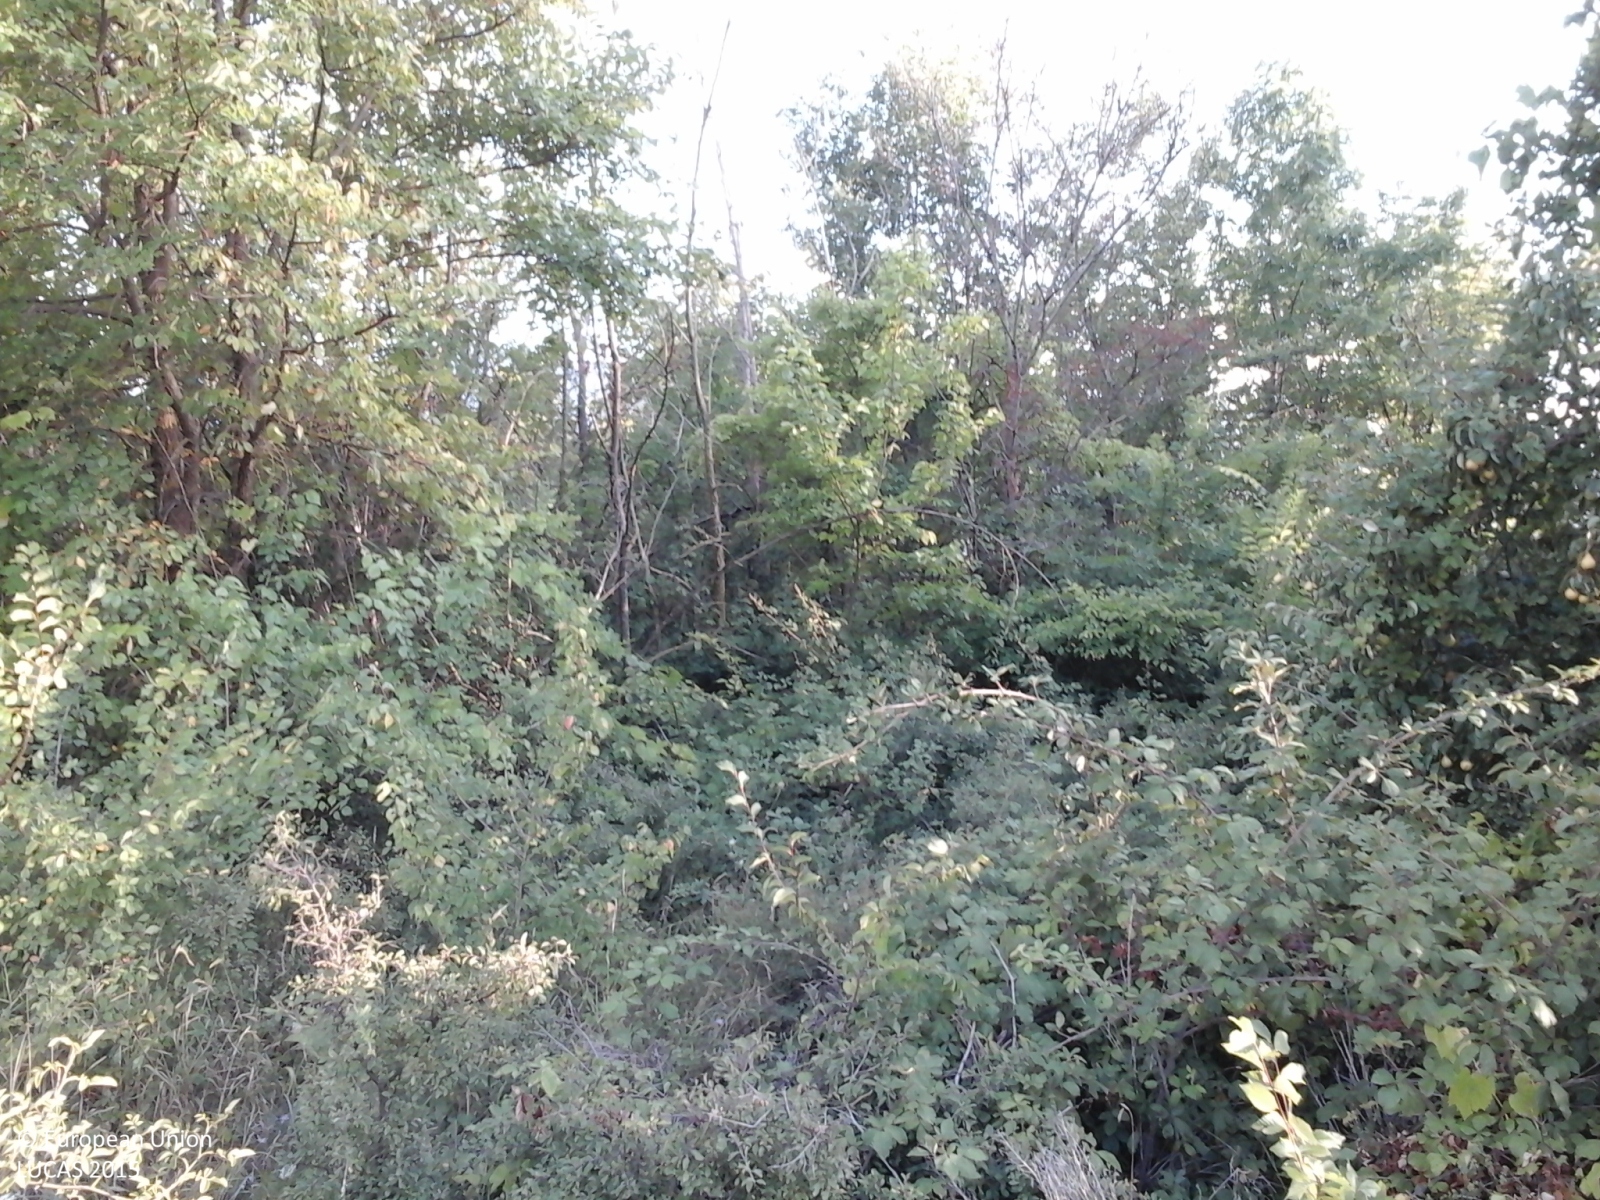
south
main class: Shrubland
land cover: Shrubland with sparse tree cover
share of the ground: > 75 %
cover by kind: shrubs 90 %, broadleaved forest trees 5 %, herbaceous plants 5 %
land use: Semi-natural and natural areas not in use
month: August
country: IT
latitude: 41.6042
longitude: 14.2923
